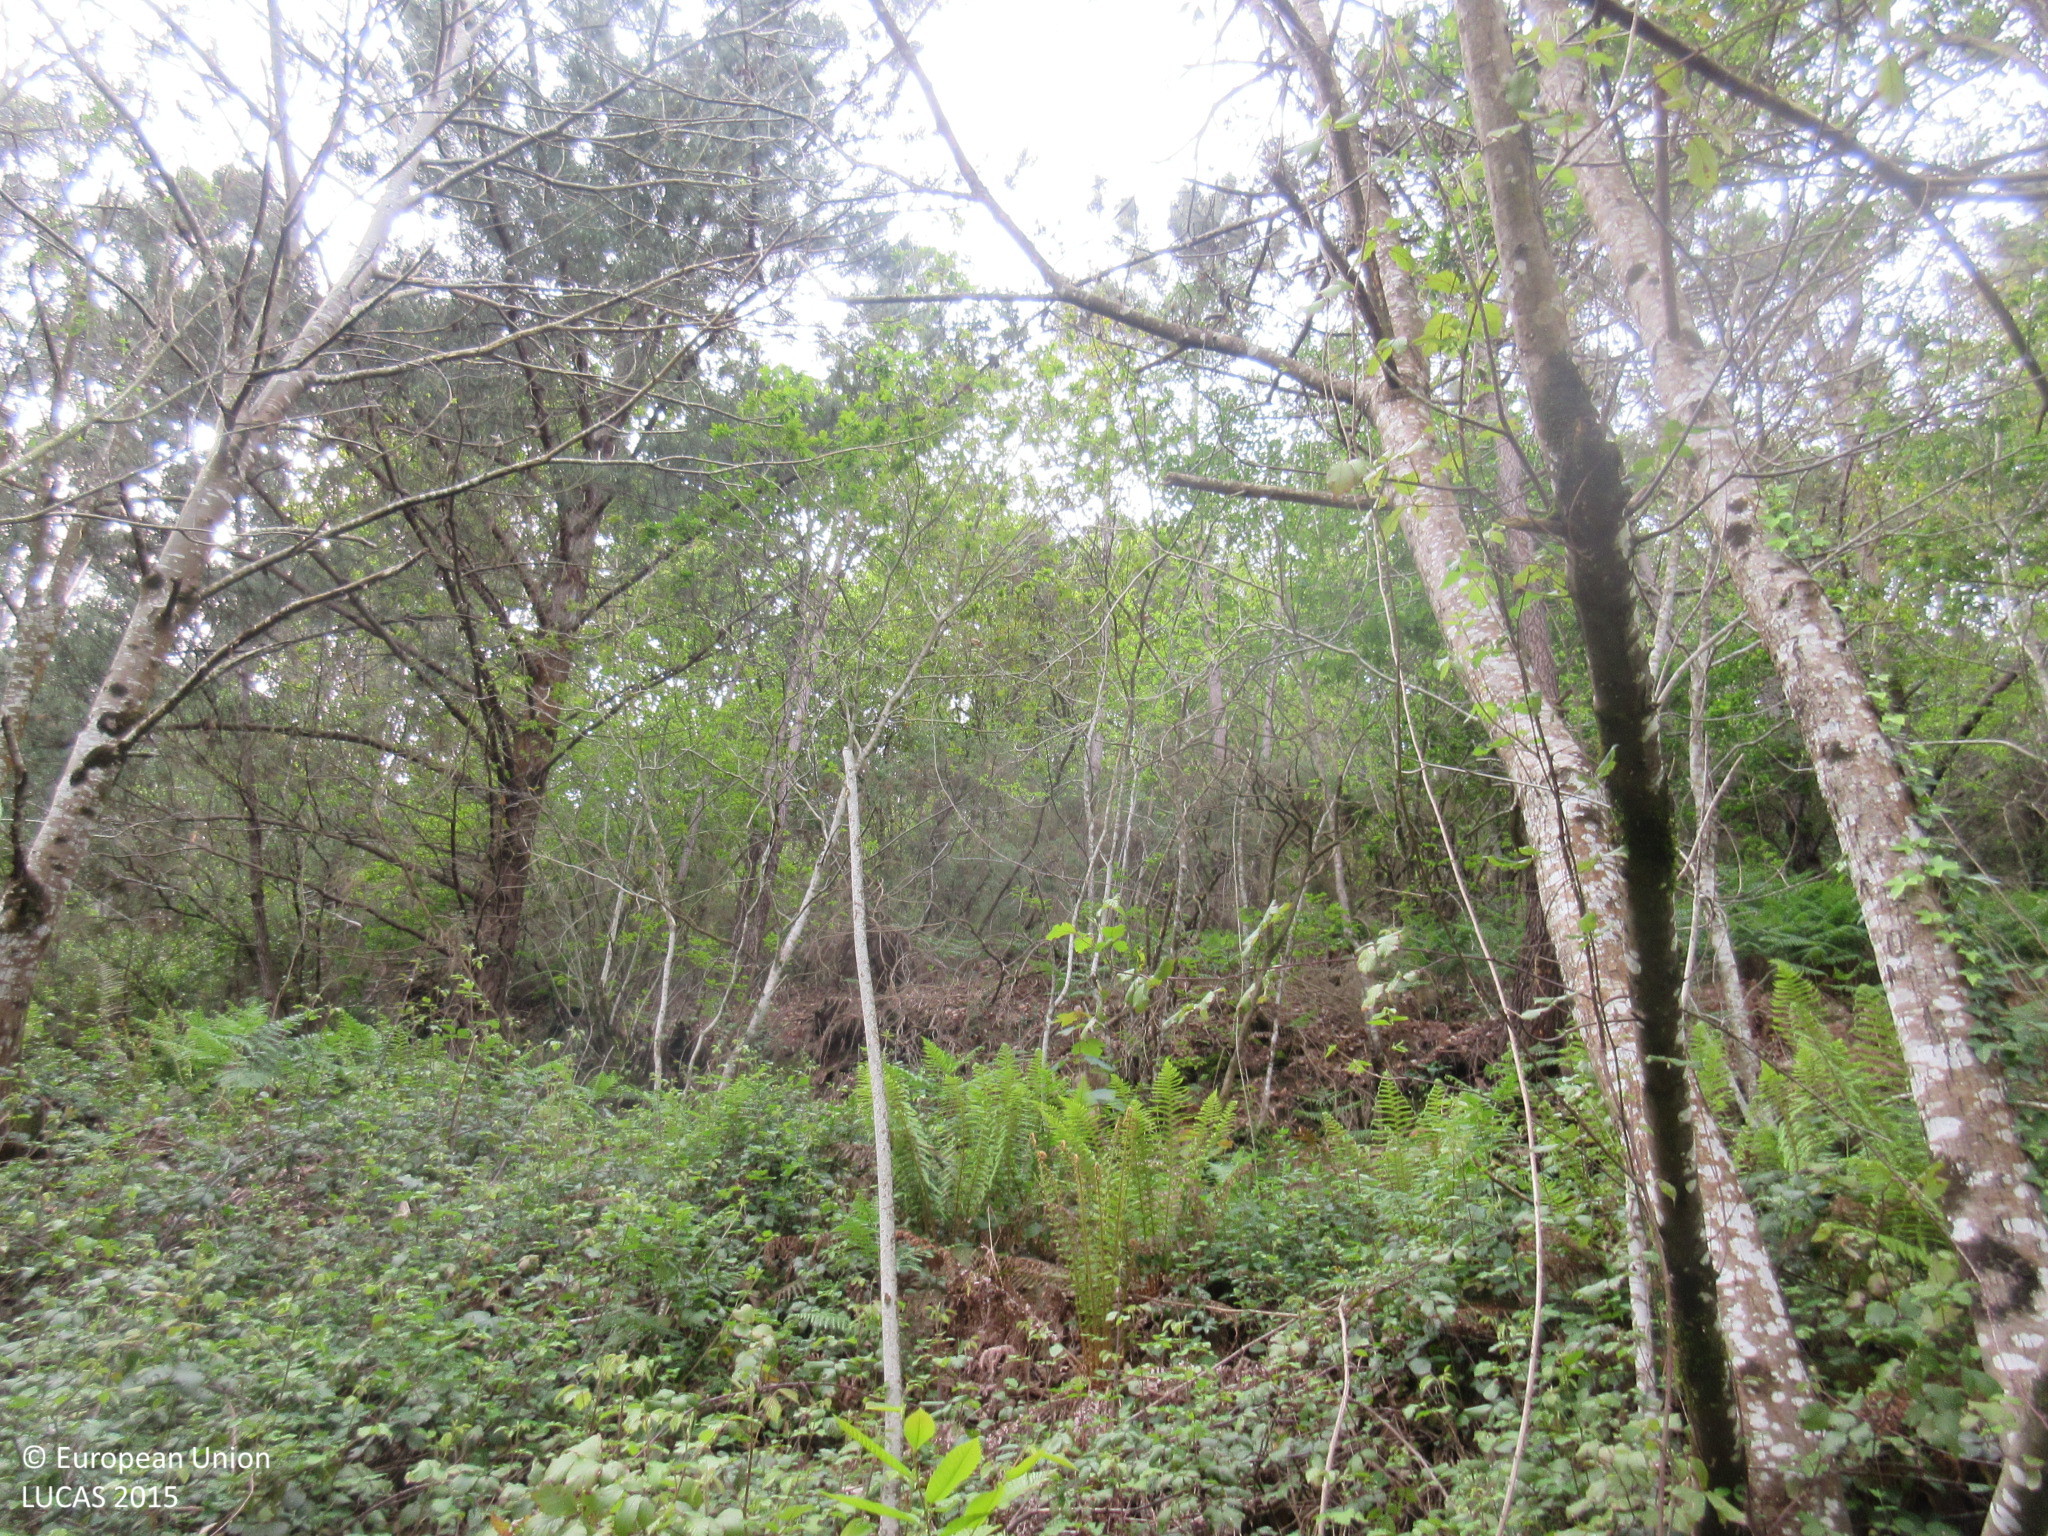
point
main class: Woodland
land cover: Broadleaved woodland
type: acidophilous oak and oak-birch forest
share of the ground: > 75 %
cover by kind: broadleaved forest trees 100 %
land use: Forestry
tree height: > 5 m
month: April
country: ES
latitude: 43.5059
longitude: -6.4423
